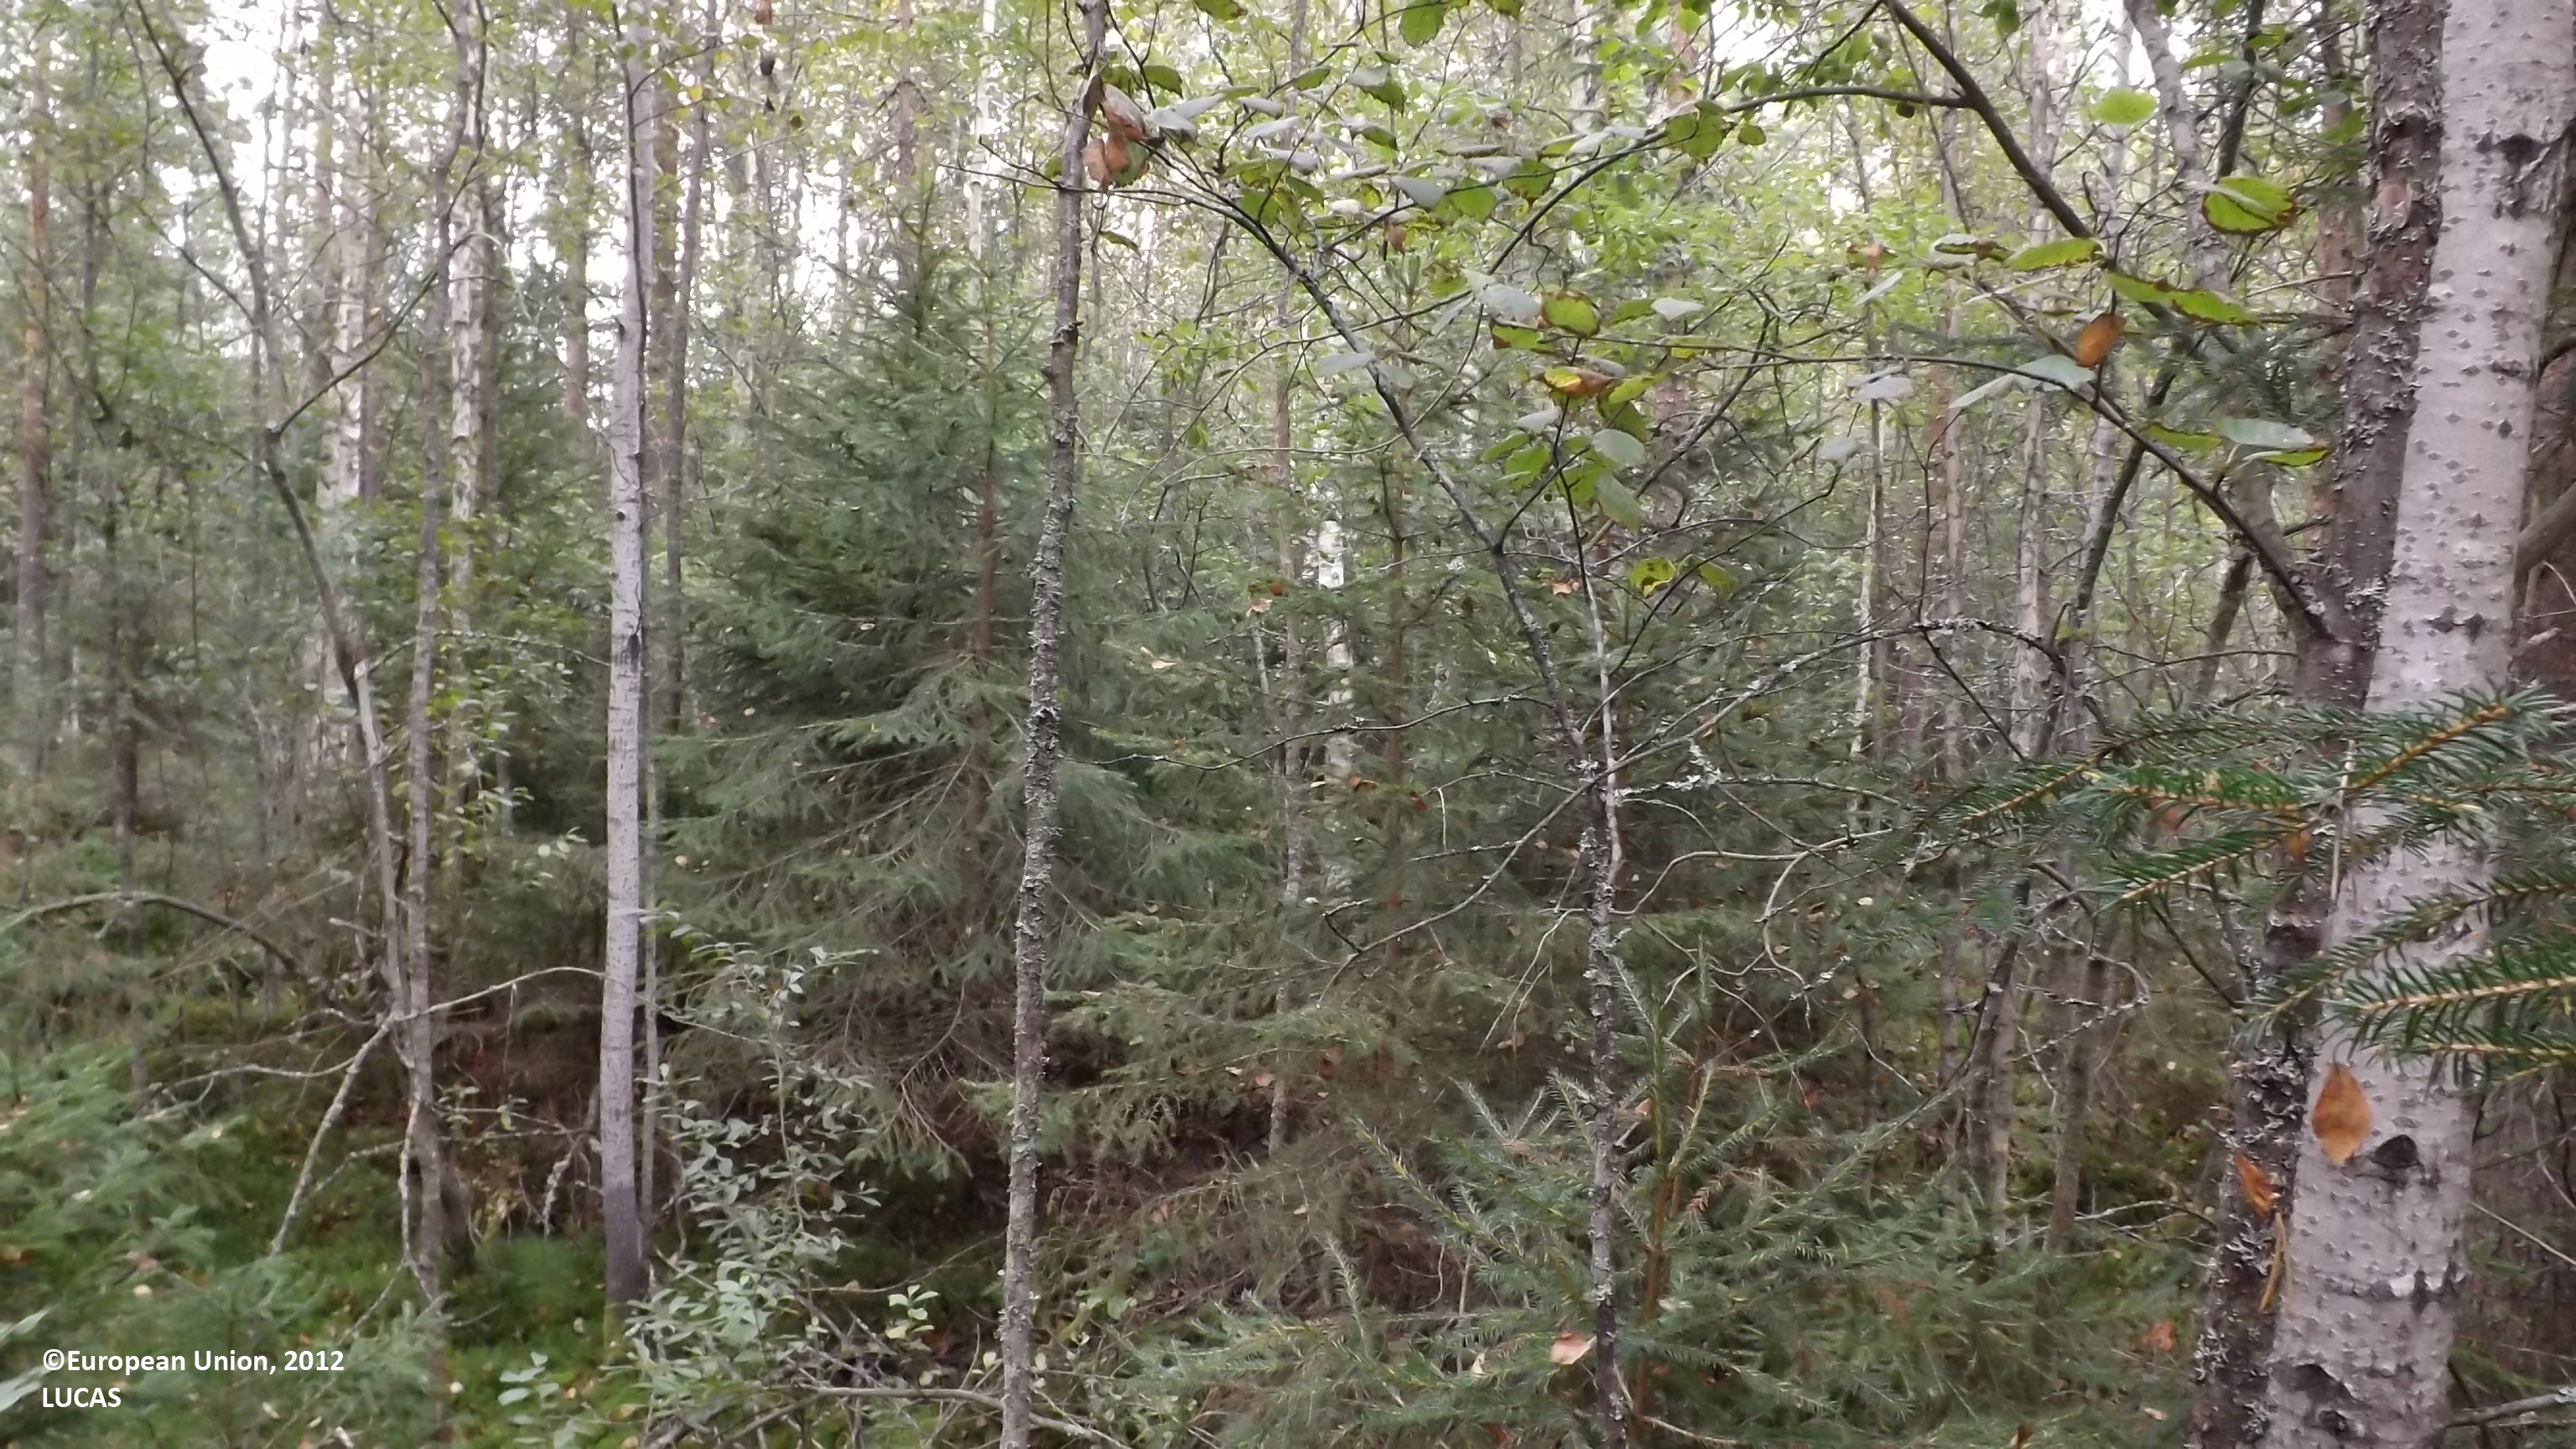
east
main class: Woodland
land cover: Other mixed woodland
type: boreal forest
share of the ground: > 75 %
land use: Forestry
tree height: > 5 m
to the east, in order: Other mixed woodland; Ditches and canals; Other mixed woodland; Ditches and canals; Other mixed woodland; Ditches and canals; Spruce dominated mixed woodland; Other mixed woodland; Ditches and canals; Other mixed woodland; Pine dominated mixed woodland; Ditches and canals; Other mixed woodland; Ditches and canals; Other mixed woodland; Other coniferous woodland; Other mixed woodland; Ditches and canals; Other mixed woodland
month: August
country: FI
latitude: 63.8615
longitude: 24.0448
